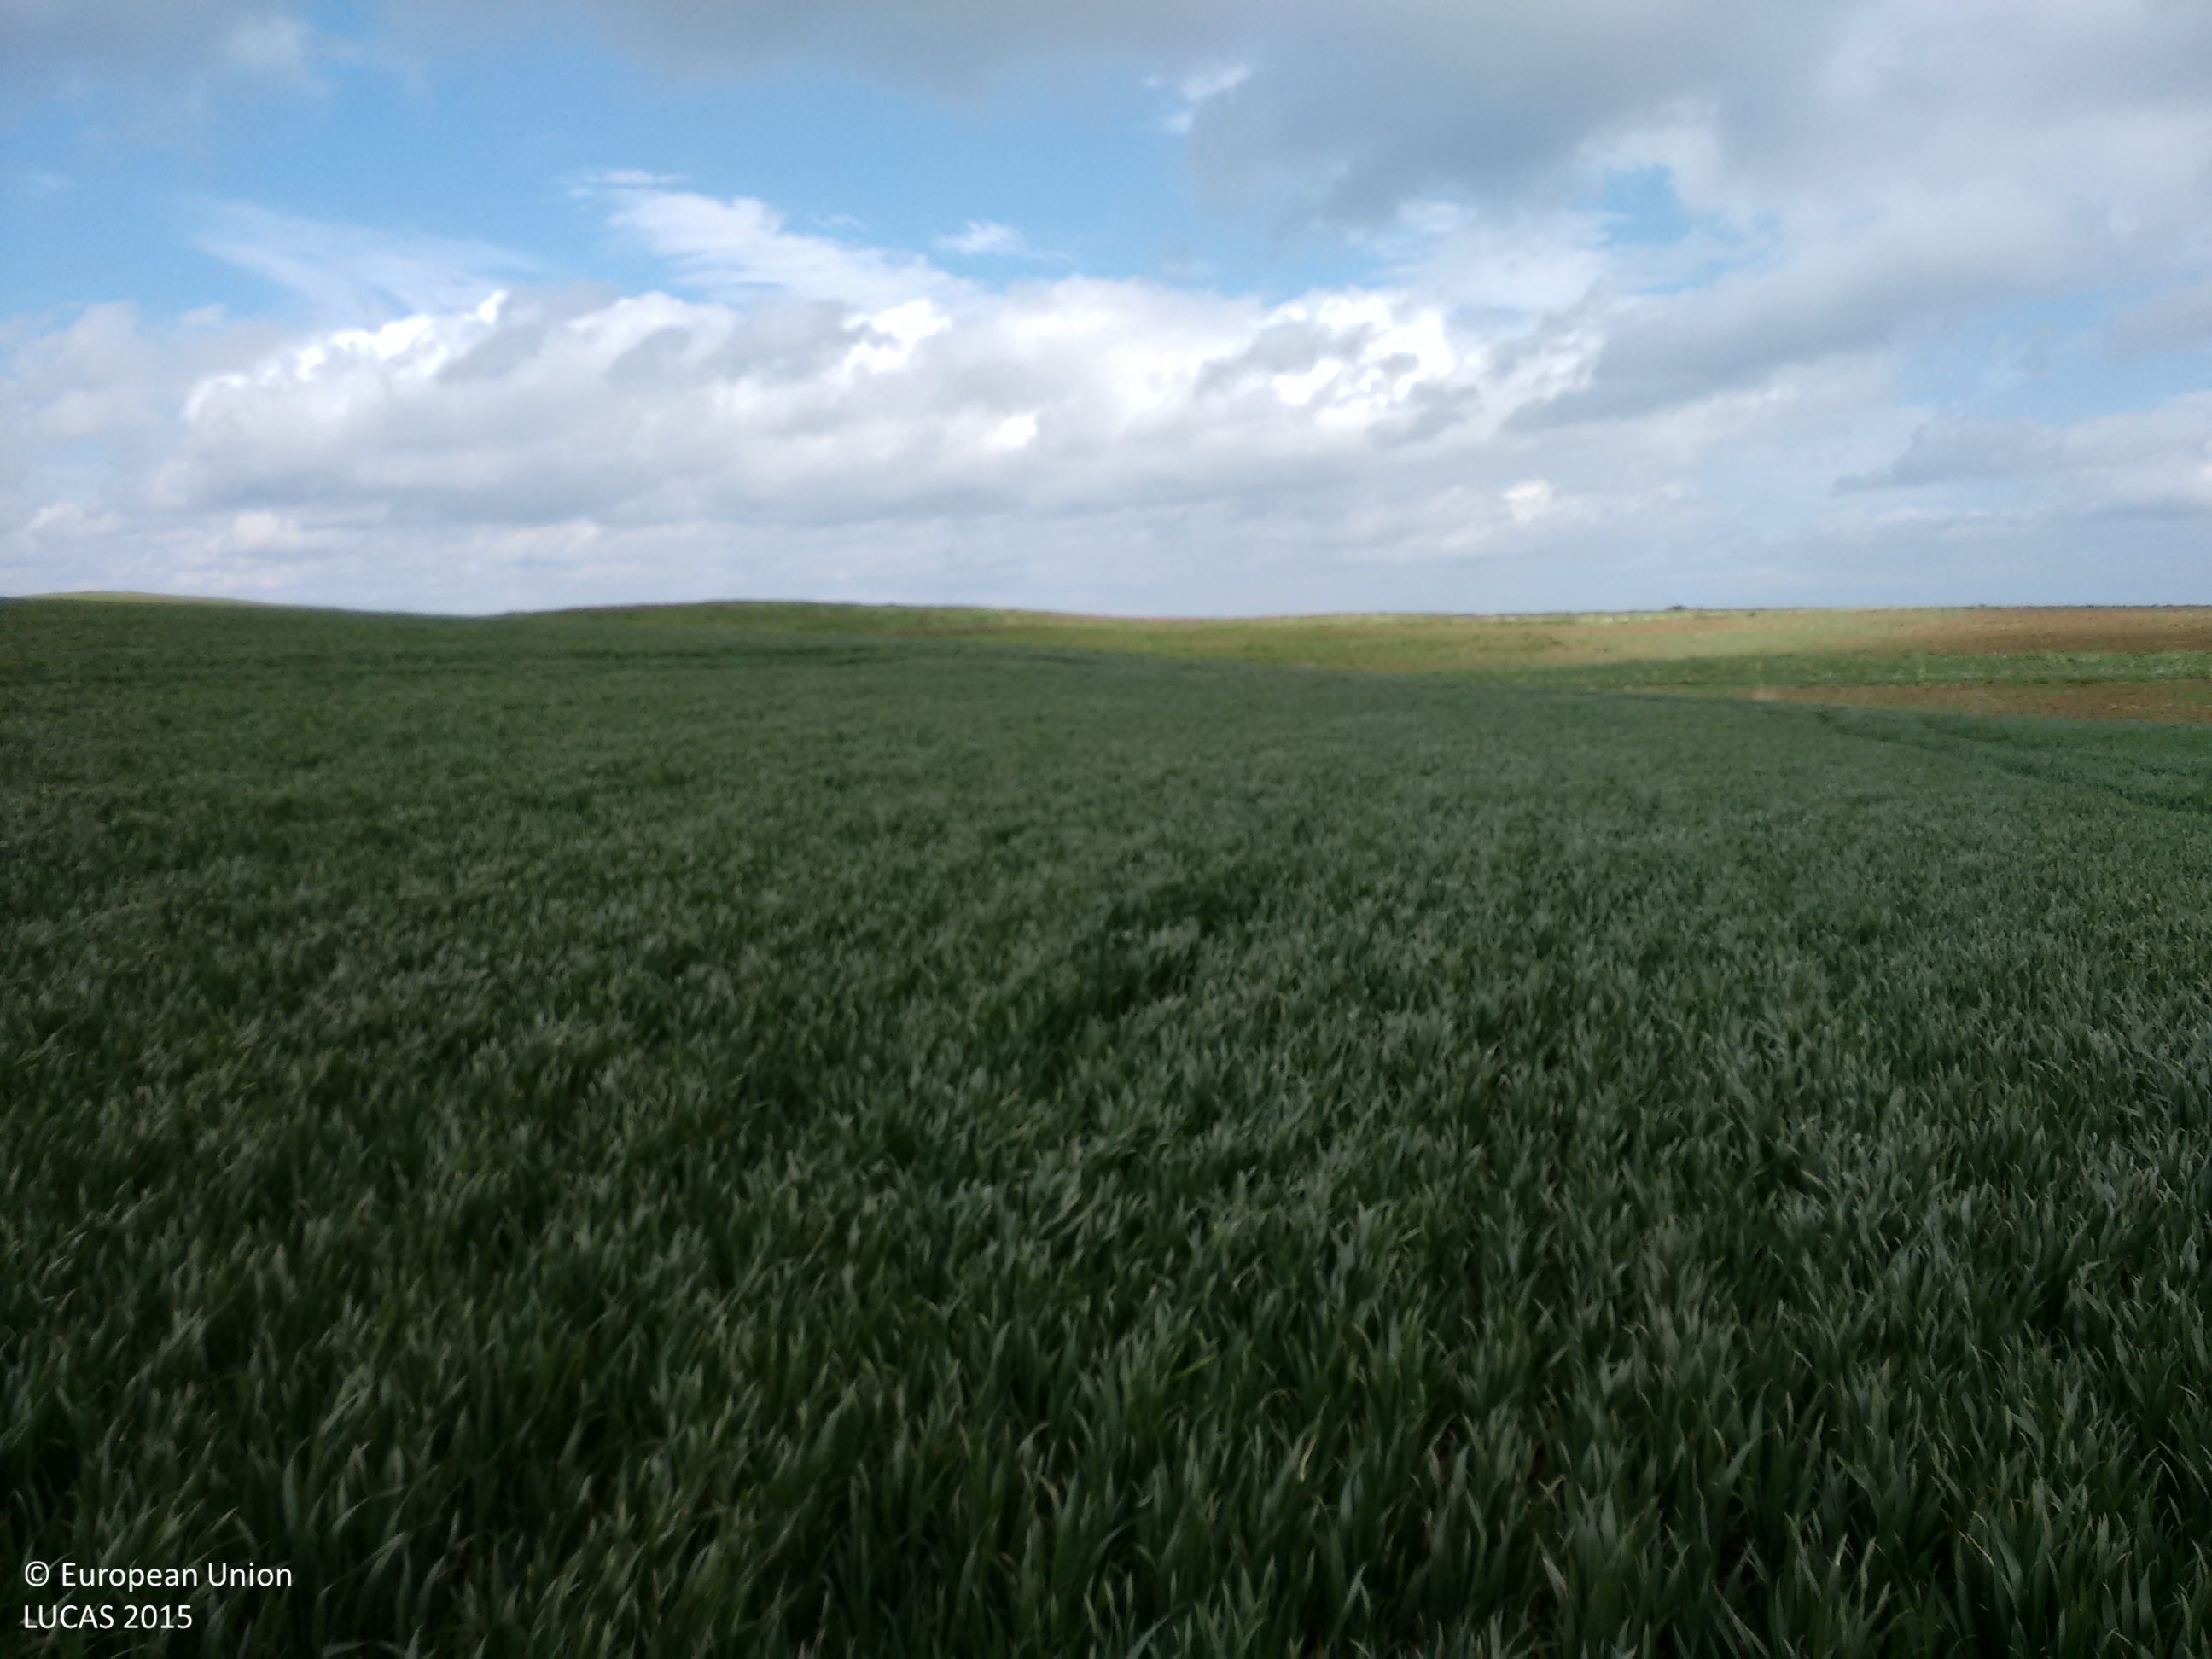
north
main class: Cropland
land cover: Common wheat
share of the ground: > 75 %
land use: Agriculture (excluding fallow land and kitchen gardens)
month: May
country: GB
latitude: 54.1498
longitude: -0.1837
